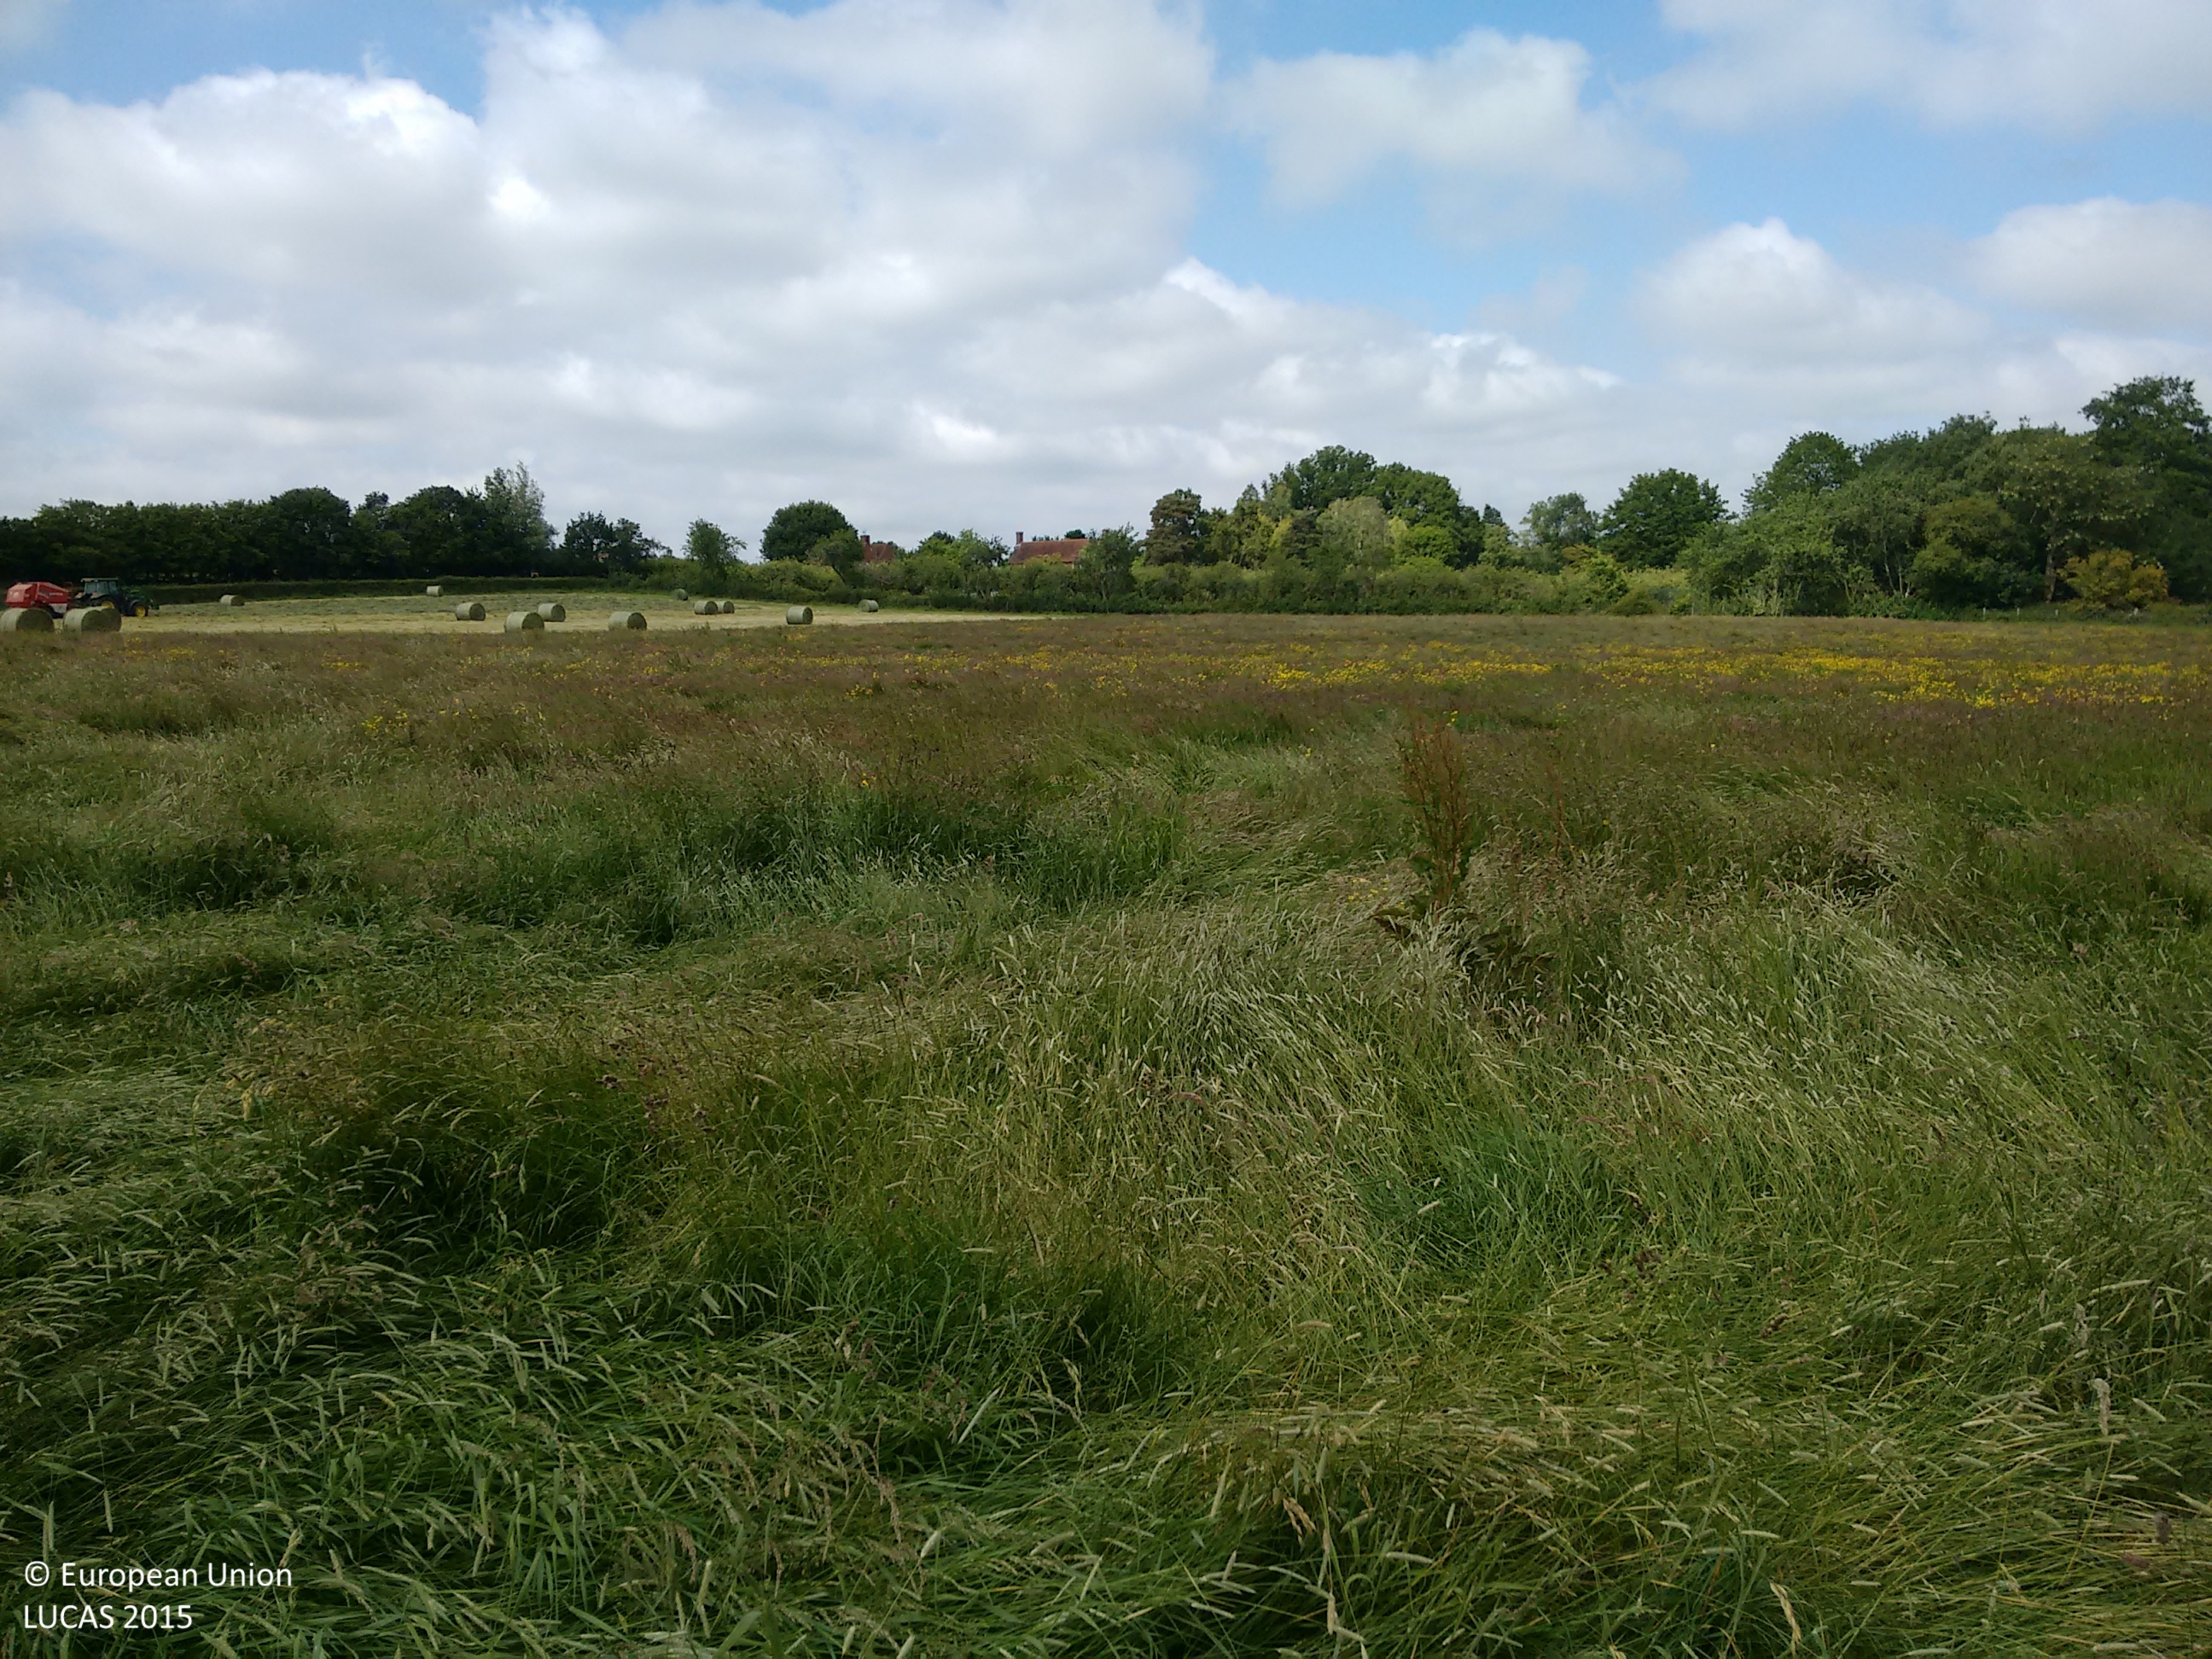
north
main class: Grassland
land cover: Grassland without tree/shrub cover
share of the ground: > 75 %
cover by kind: herbaceous plants 100 %
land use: Agriculture (excluding fallow land and kitchen gardens)
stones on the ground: < 10 %
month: June
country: GB
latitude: 51.1335
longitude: 0.5838
